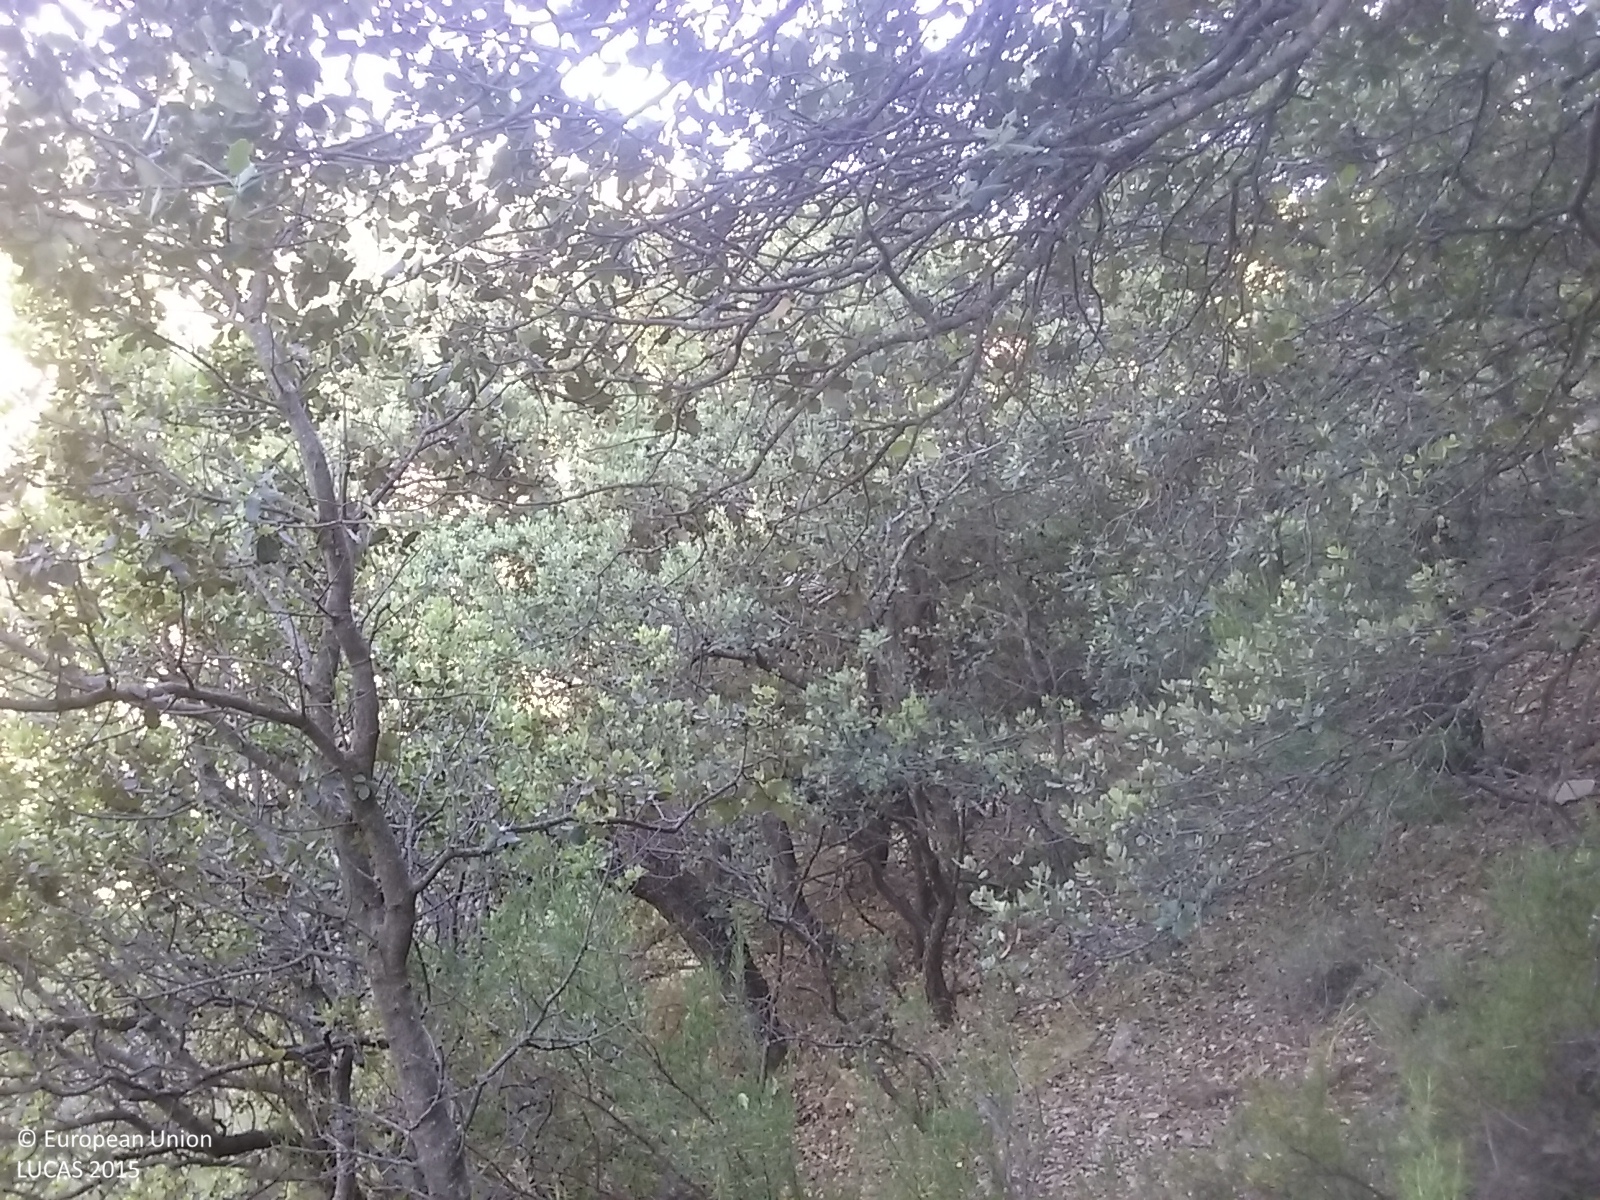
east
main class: Woodland
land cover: Pine dominated mixed woodland
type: coniferous forest of the mediterranean region
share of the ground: > 75 %
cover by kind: coniferous forest trees 50 %, broadleaved forest trees 40 %, shrubs 10 %
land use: Semi-natural and natural areas not in use
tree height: > 5 m
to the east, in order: Pine dominated mixed woodland; Dry stone walls; Pine dominated mixed woodland; Broadleaved woodland; Rocks and stones; Broadleaved woodland; Shrubland with sparse tree cover; Dry stone walls; Pine dominated coniferous woodland; Dry stone walls; Pine dominated coniferous woodland; Dry stone walls; Pine dominated mixed woodland; Tracks; Pine dominated mixed woodland
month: June
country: ES
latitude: 40.7301
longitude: -0.0843
